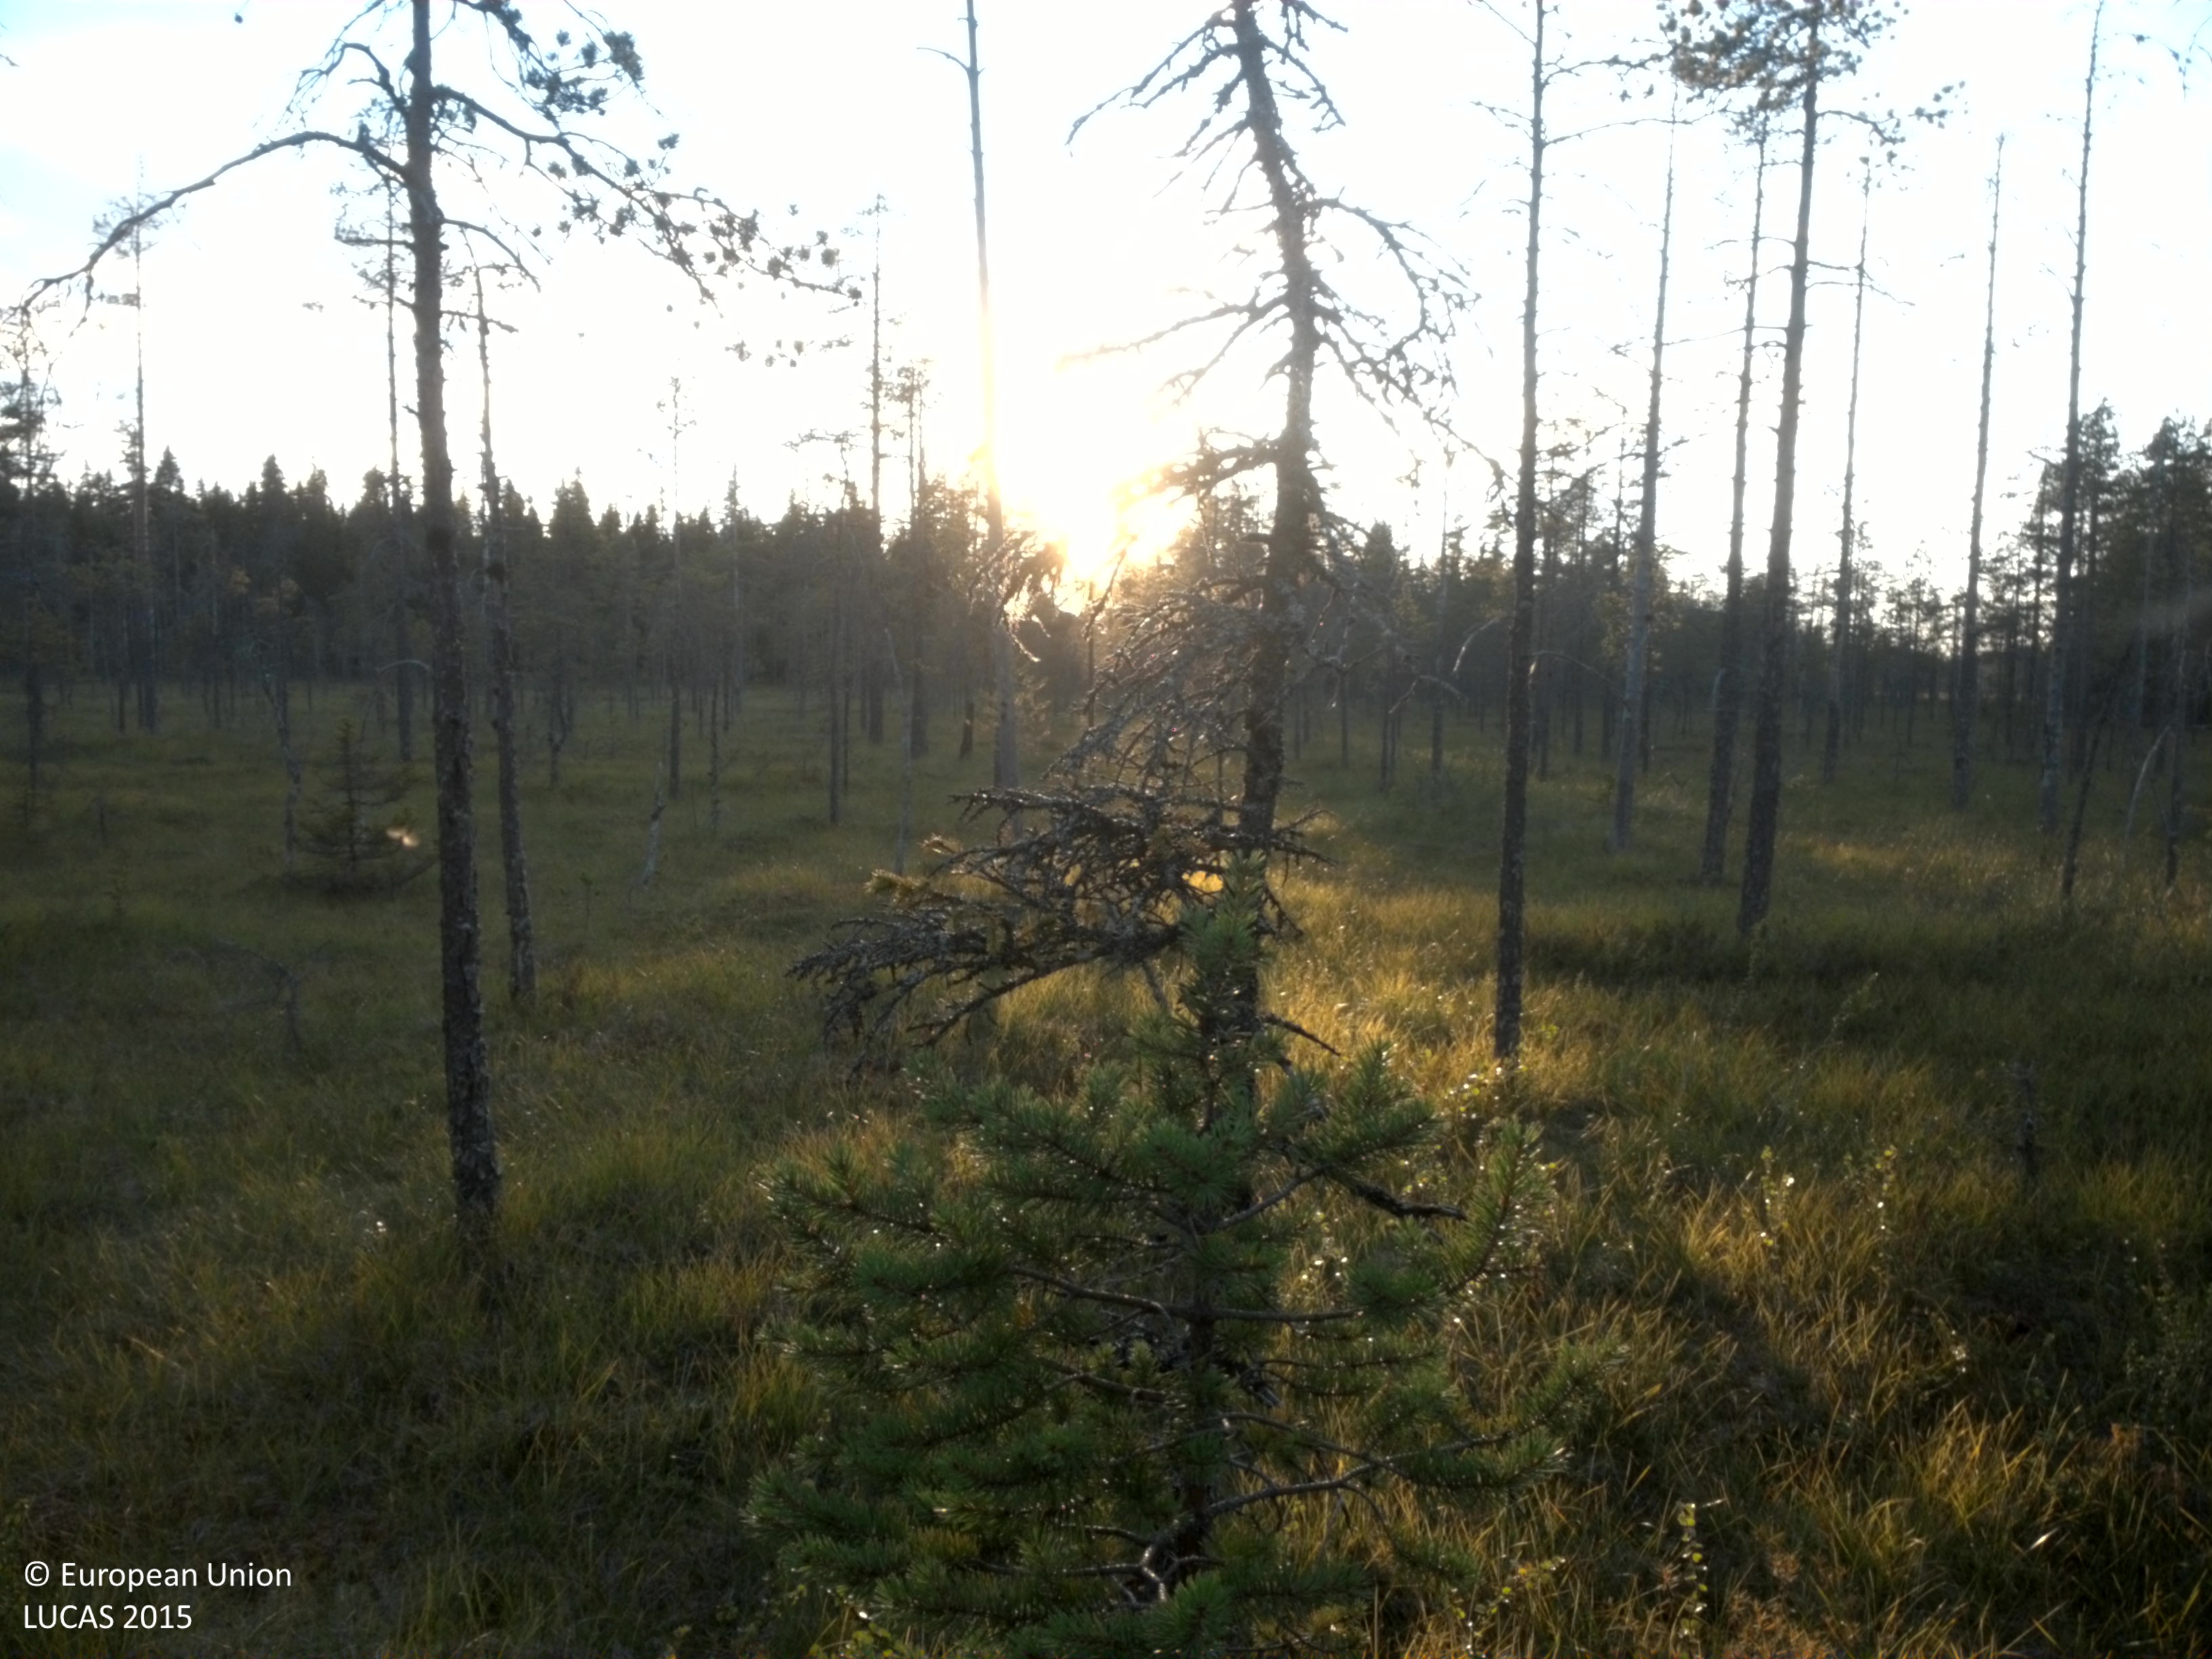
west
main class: Woodland
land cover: Pine dominated coniferous woodland
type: mire and swamp forests
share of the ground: 10 - 25 %
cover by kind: herbaceous plants 50 %, coniferous forest trees 20 %, shrubs 20 %, lichens and mosses 10 %
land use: Semi-natural and natural areas not in use
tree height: < 5 m
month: August
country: SE
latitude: 64.5298
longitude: 20.1242
